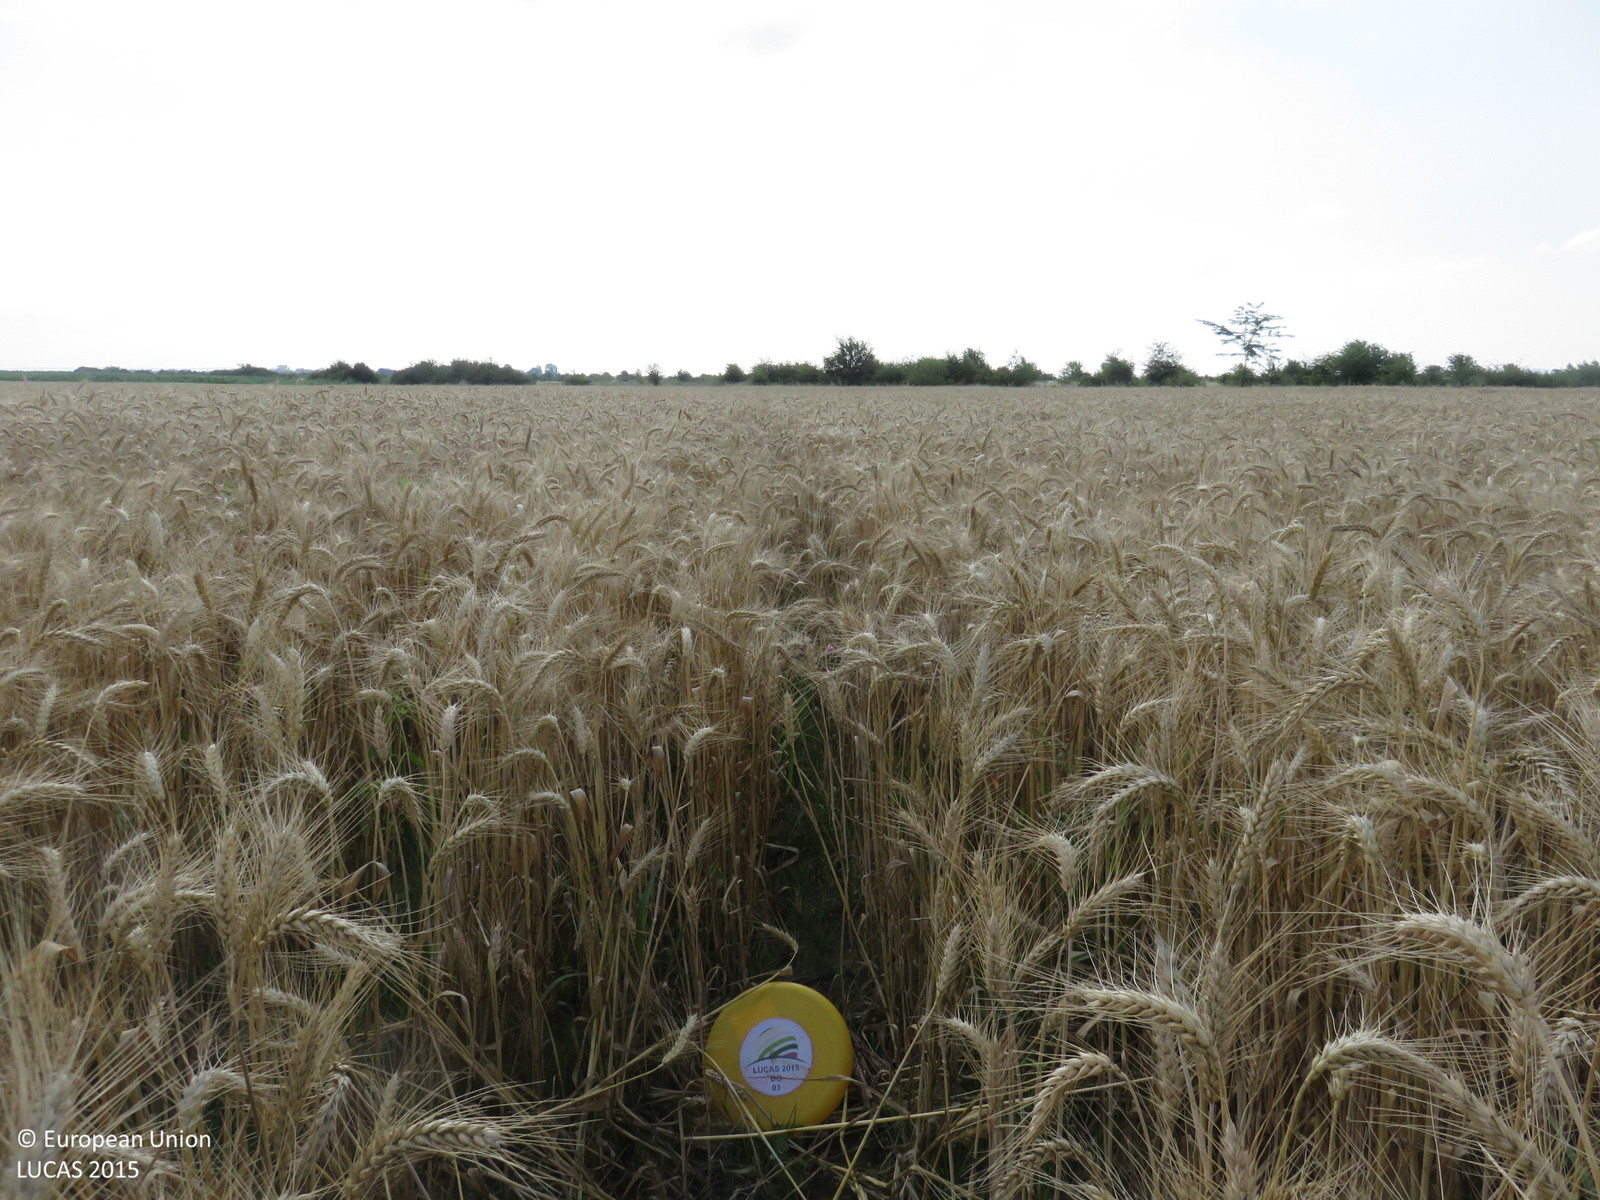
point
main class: Cropland
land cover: Common wheat
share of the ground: > 75 %
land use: Agriculture (excluding fallow land and kitchen gardens)
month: June
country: BG
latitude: 43.3292
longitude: 24.9793
